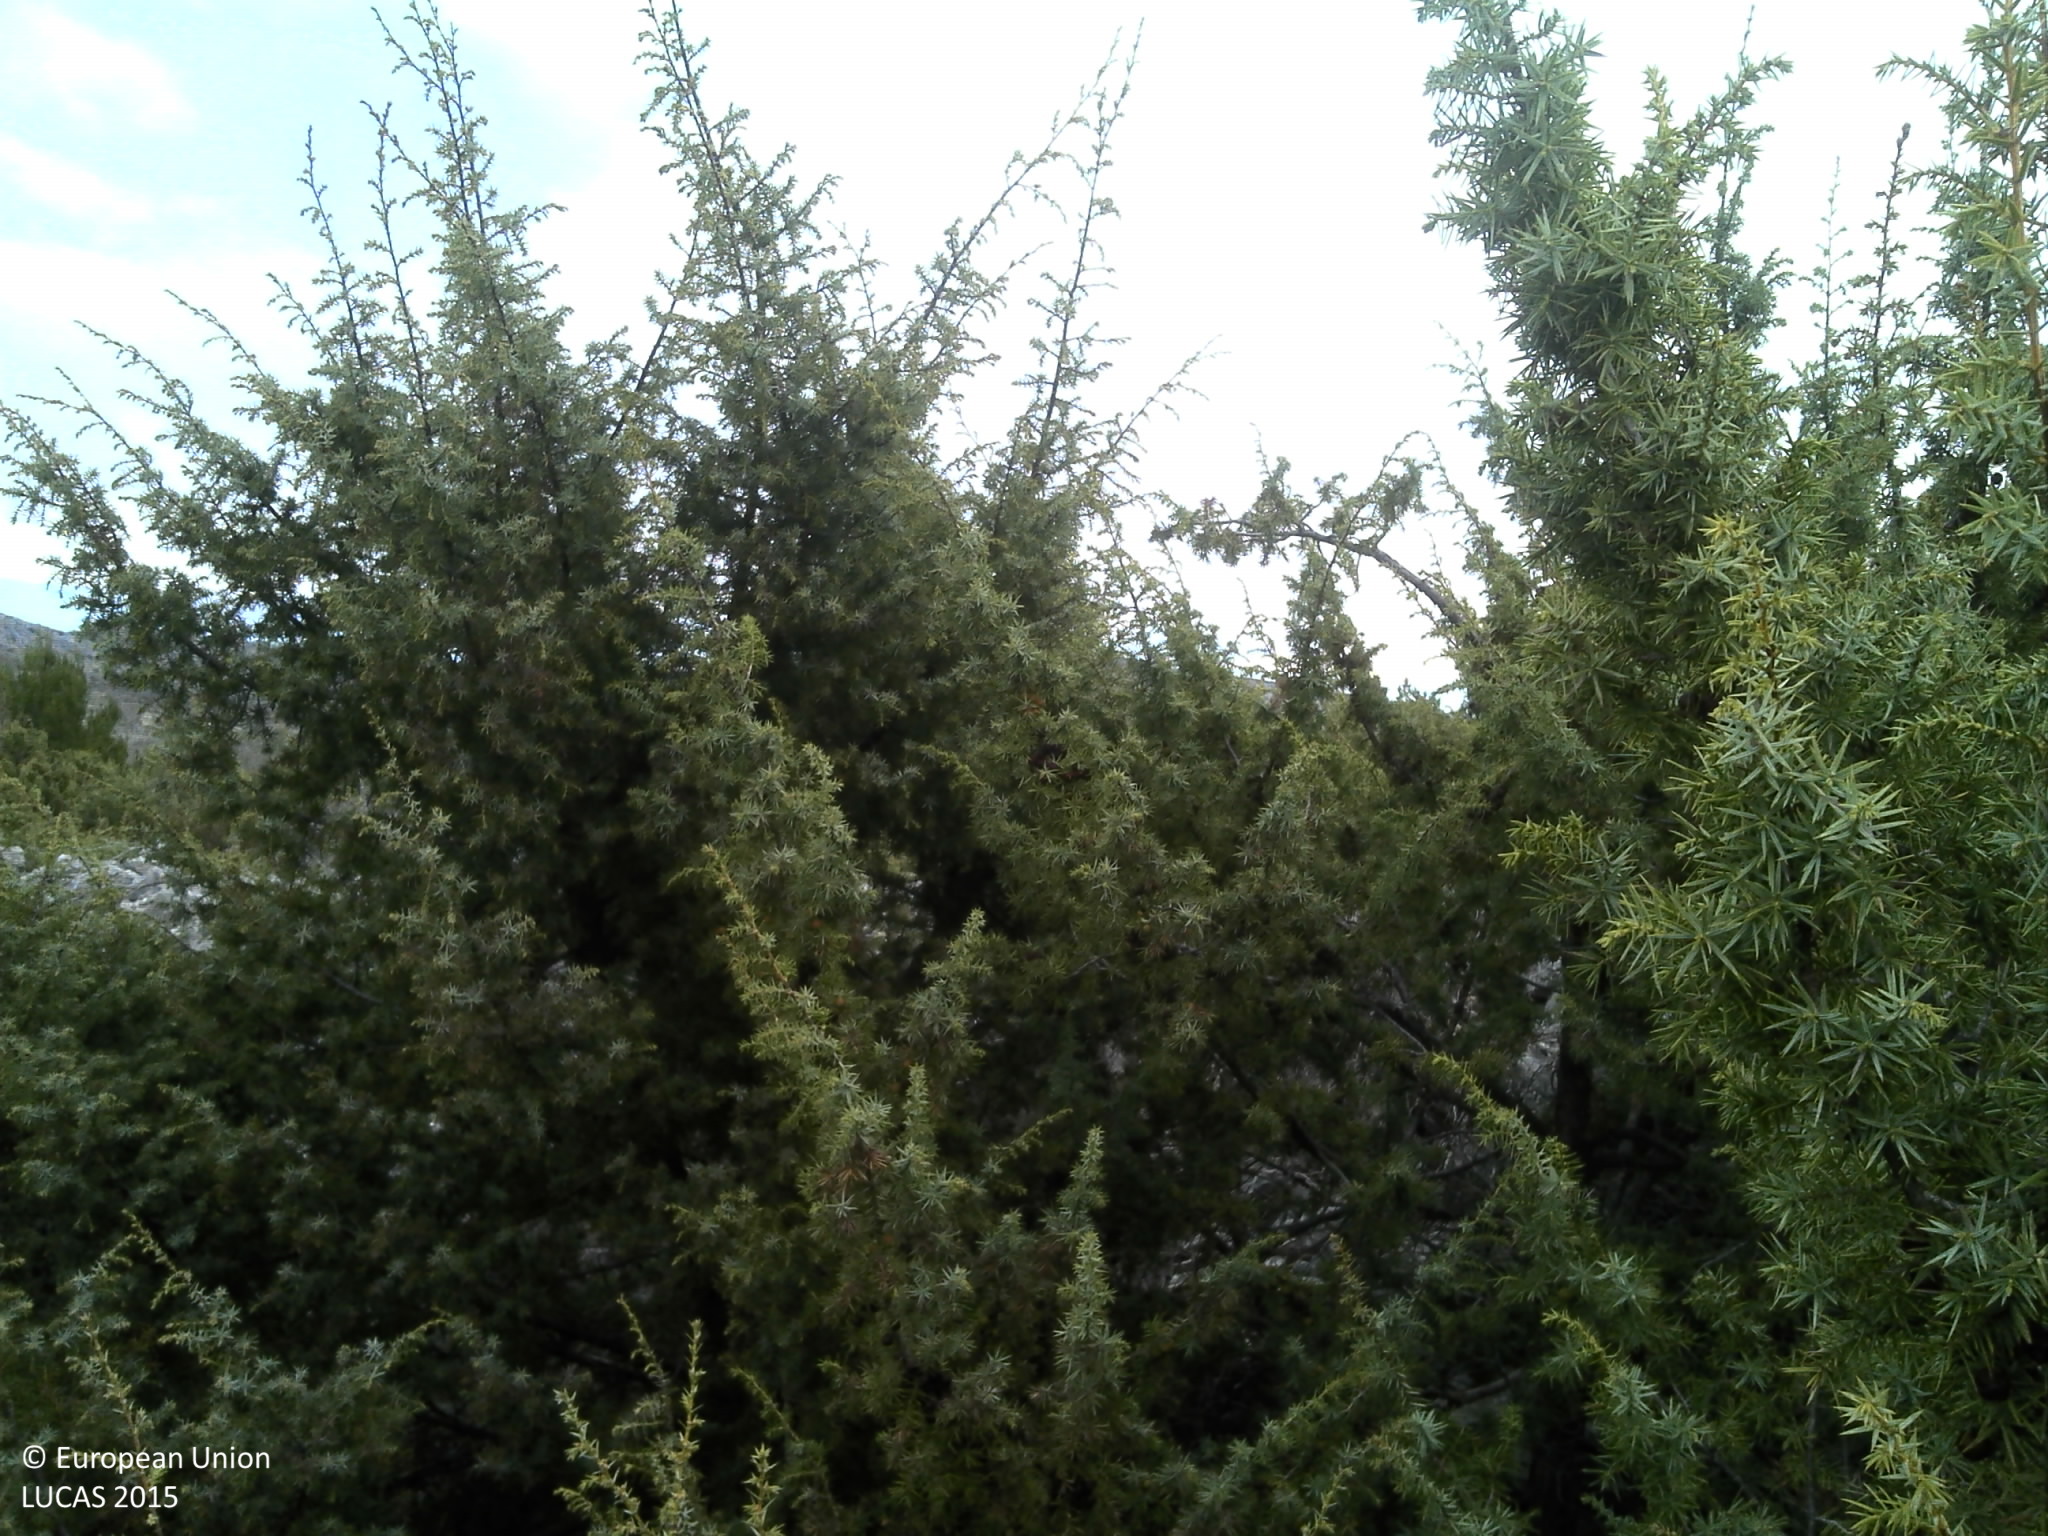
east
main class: Shrubland
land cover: Shrubland with sparse tree cover
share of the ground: > 75 %
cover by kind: shrubs 75 %, unconsolidated bare surface 10 %, coniferous forest trees 5 %, herbaceous plants 5 %, consolidated bare surface 5 %
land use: Abandoned areas
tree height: < 5 m
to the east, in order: Shrubland with sparse tree cover; Dry stone walls; Tracks; Shrubland with sparse tree cover; Dry stone walls; Grassland with sparse tree/shrub cover; Broadleaved woodland; Dry stone walls; Broadleaved woodland; Dry stone walls; Broadleaved woodland; Dry stone walls; Broadleaved woodland; Dry stone walls; Shrubland with sparse tree cover; Dry stone walls; Shrubland with sparse tree cover
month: April
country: HR
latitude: 43.6823
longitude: 16.1067
